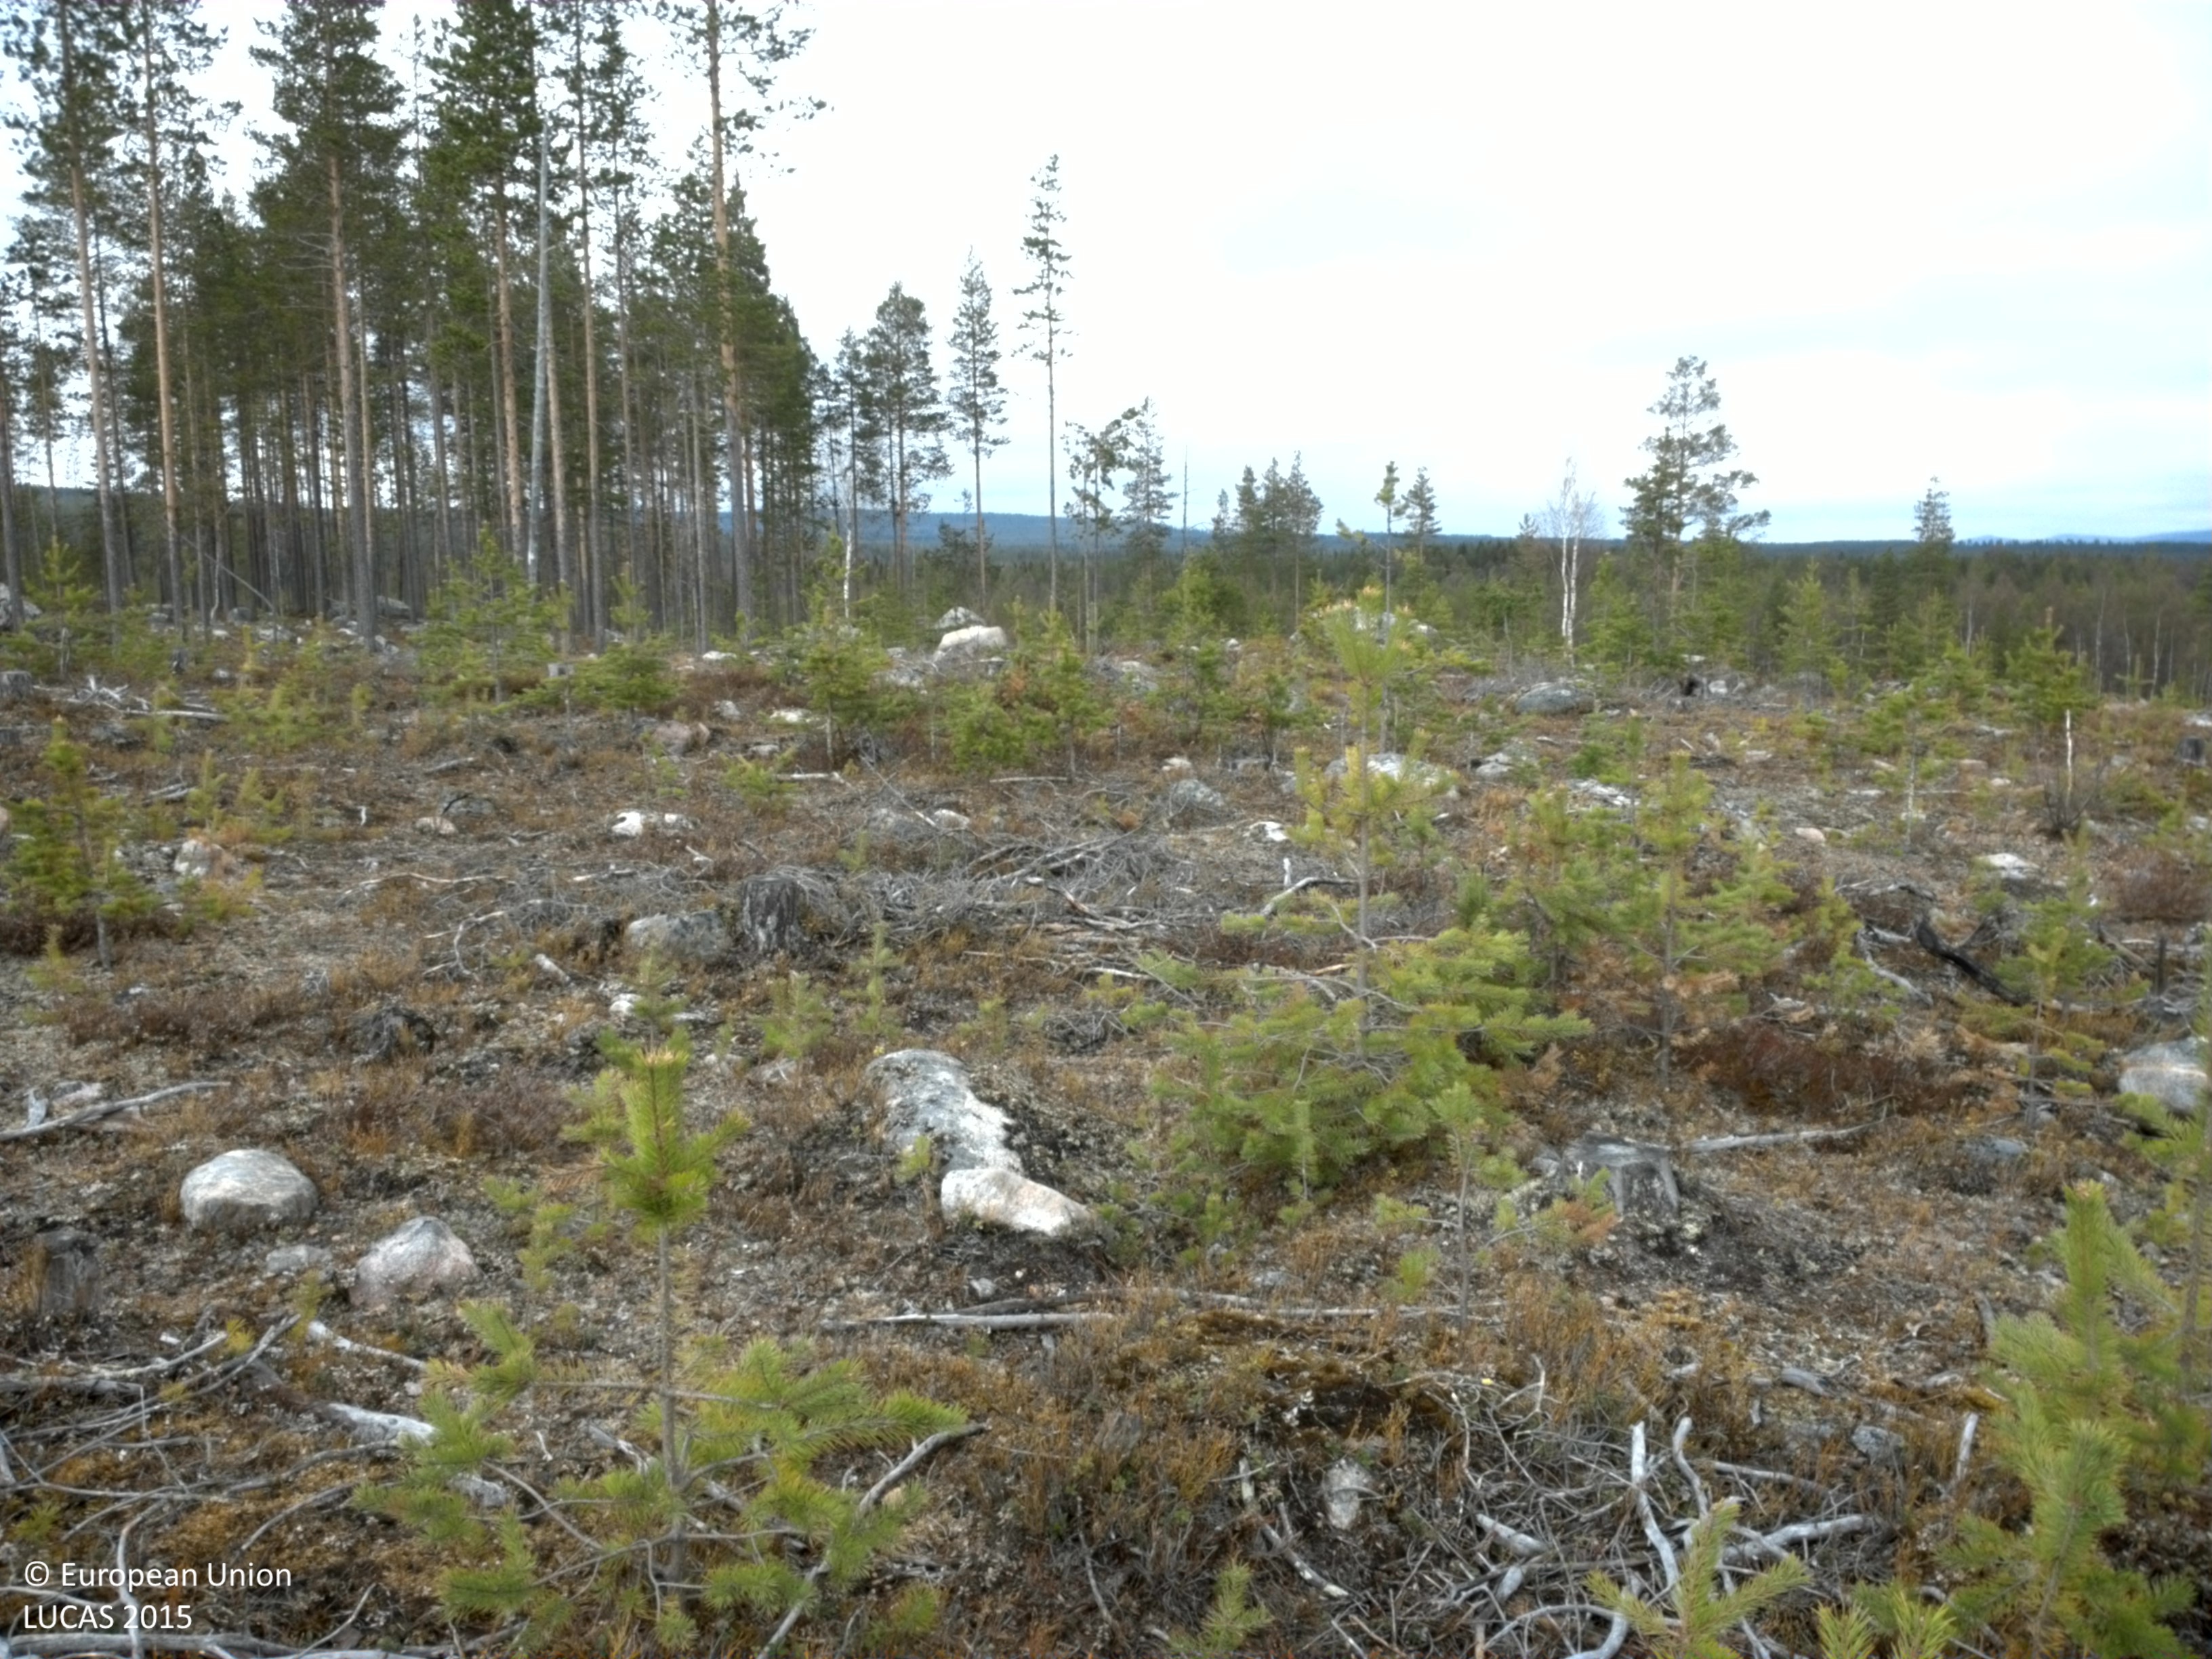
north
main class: Woodland
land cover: Pine dominated coniferous woodland
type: boreal forest
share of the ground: 25 - 50 %
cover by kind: coniferous forest trees 40 %, shrubs 40 %, lichens and mosses 15 %, unconsolidated bare surface 5 %
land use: Forestry
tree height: < 5 m
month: May
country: SE
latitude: 66.3712
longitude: 23.5583
